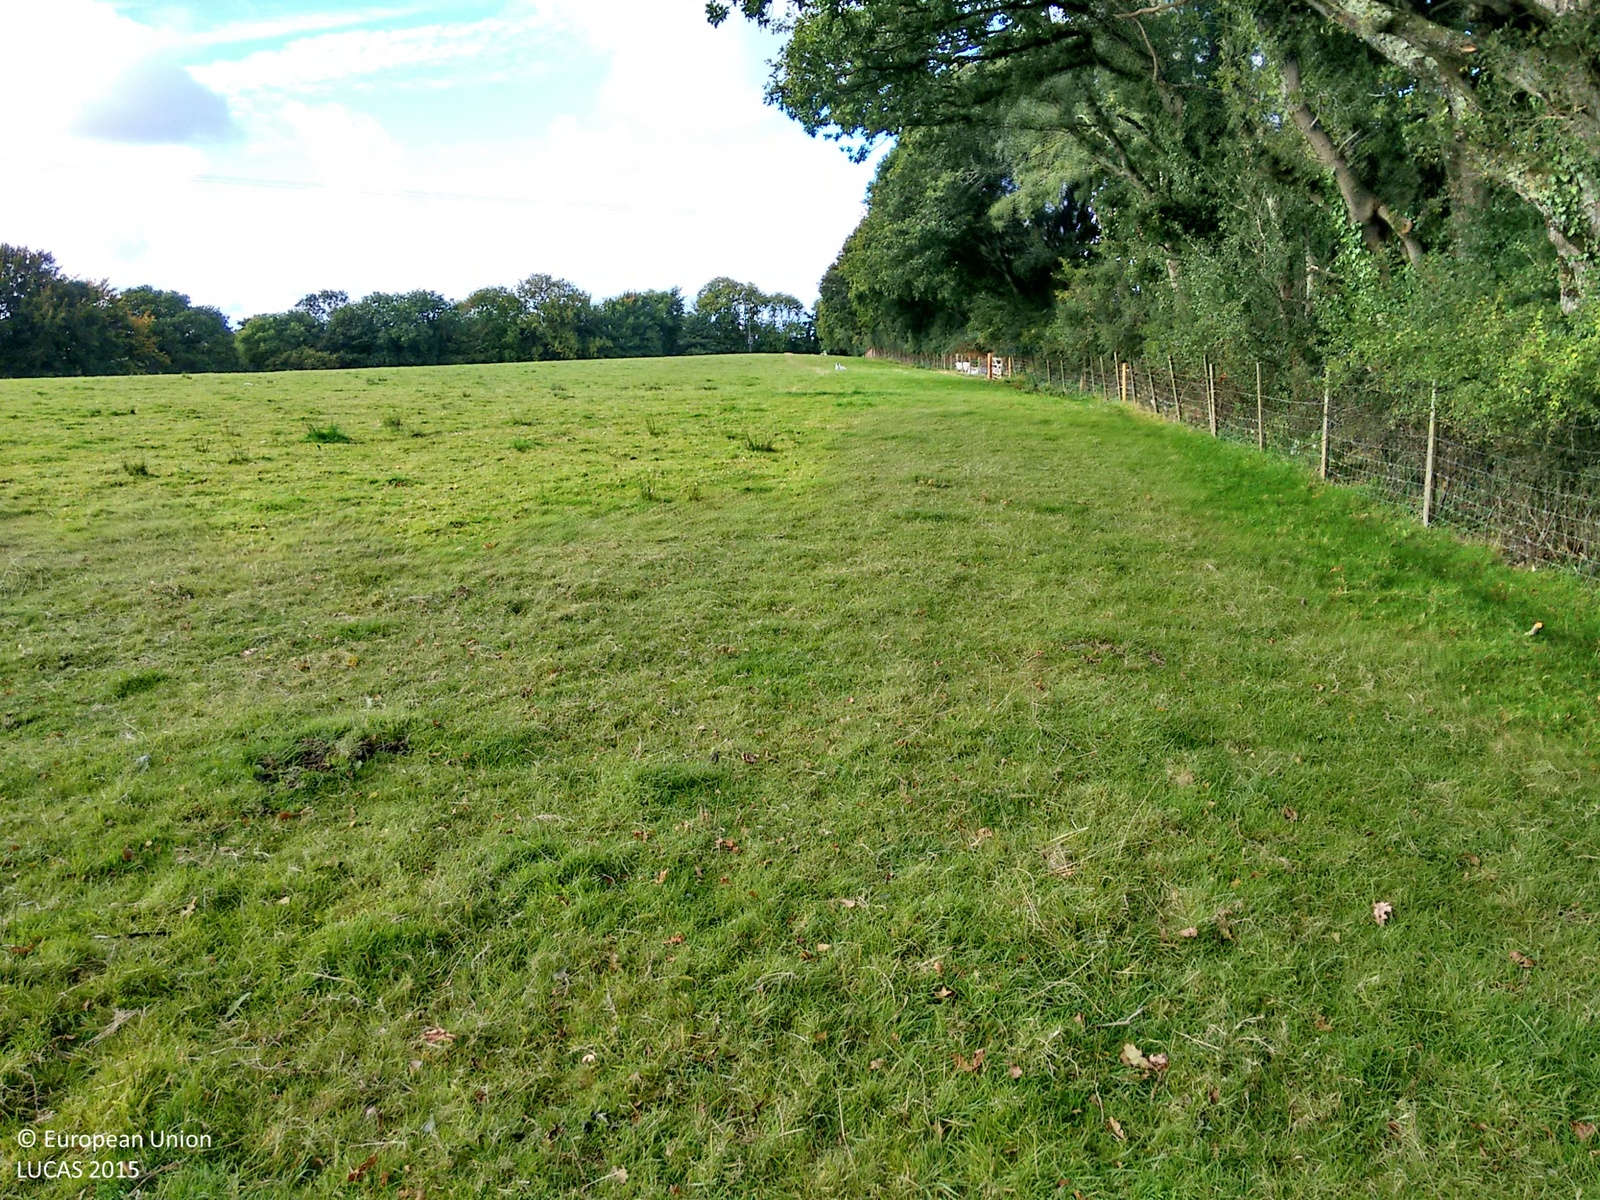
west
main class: Grassland
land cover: Grassland without tree/shrub cover
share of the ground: > 75 %
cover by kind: herbaceous plants 100 %
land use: Agriculture (excluding fallow land and kitchen gardens)
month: September
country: GB
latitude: 50.8383
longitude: -4.0831
